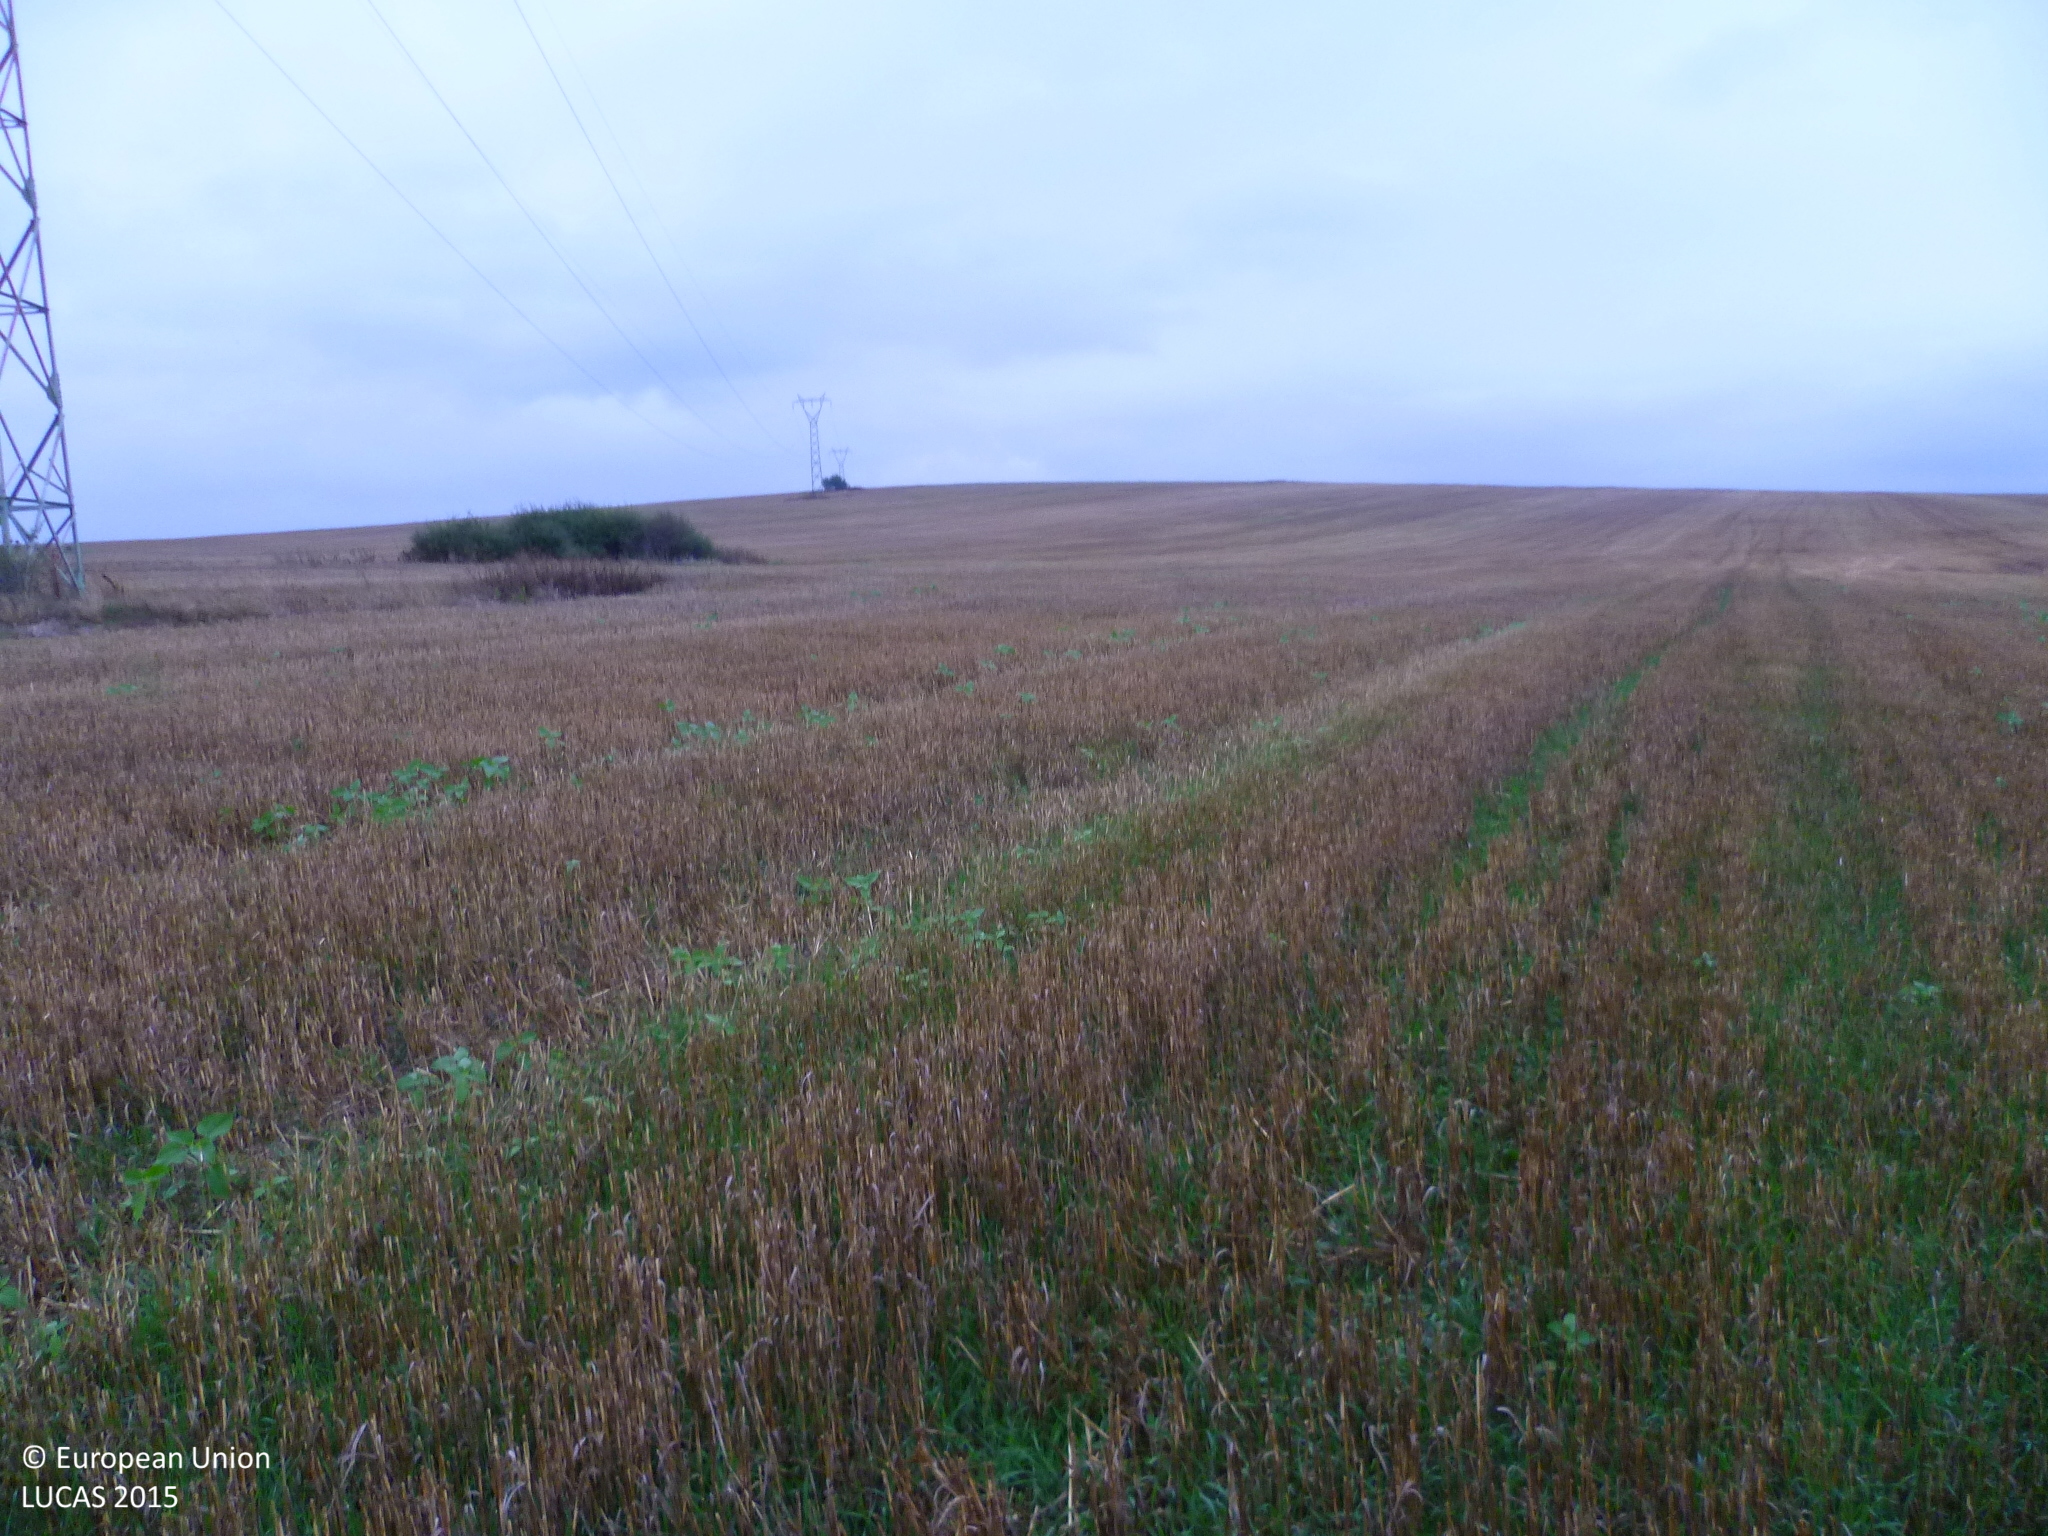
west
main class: Cropland
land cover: Barley
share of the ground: 50 - 75 %
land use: Agriculture (excluding fallow land and kitchen gardens)
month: September
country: BG
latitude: 42.6948
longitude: 22.9558
